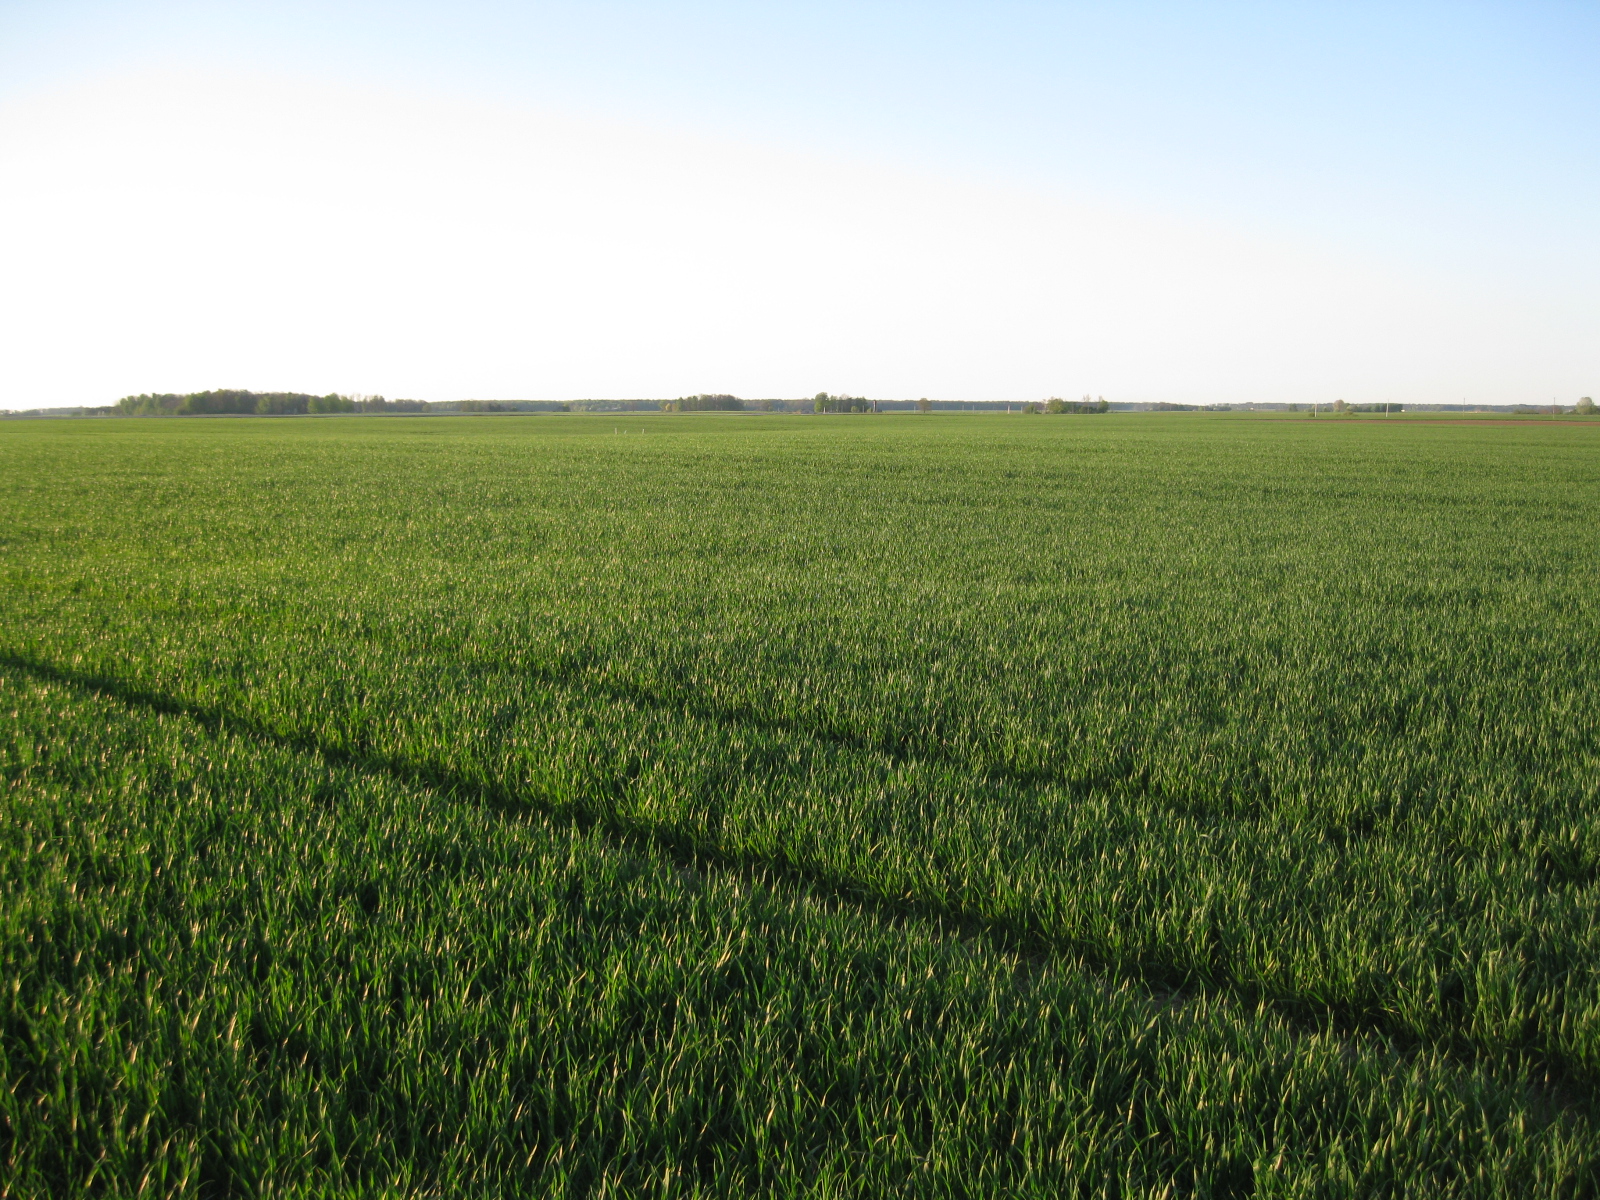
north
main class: Cropland
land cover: Common wheat
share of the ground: > 75 %
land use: Agriculture (excluding fallow land and kitchen gardens)
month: May
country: LT
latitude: 56.0993
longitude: 24.4197
